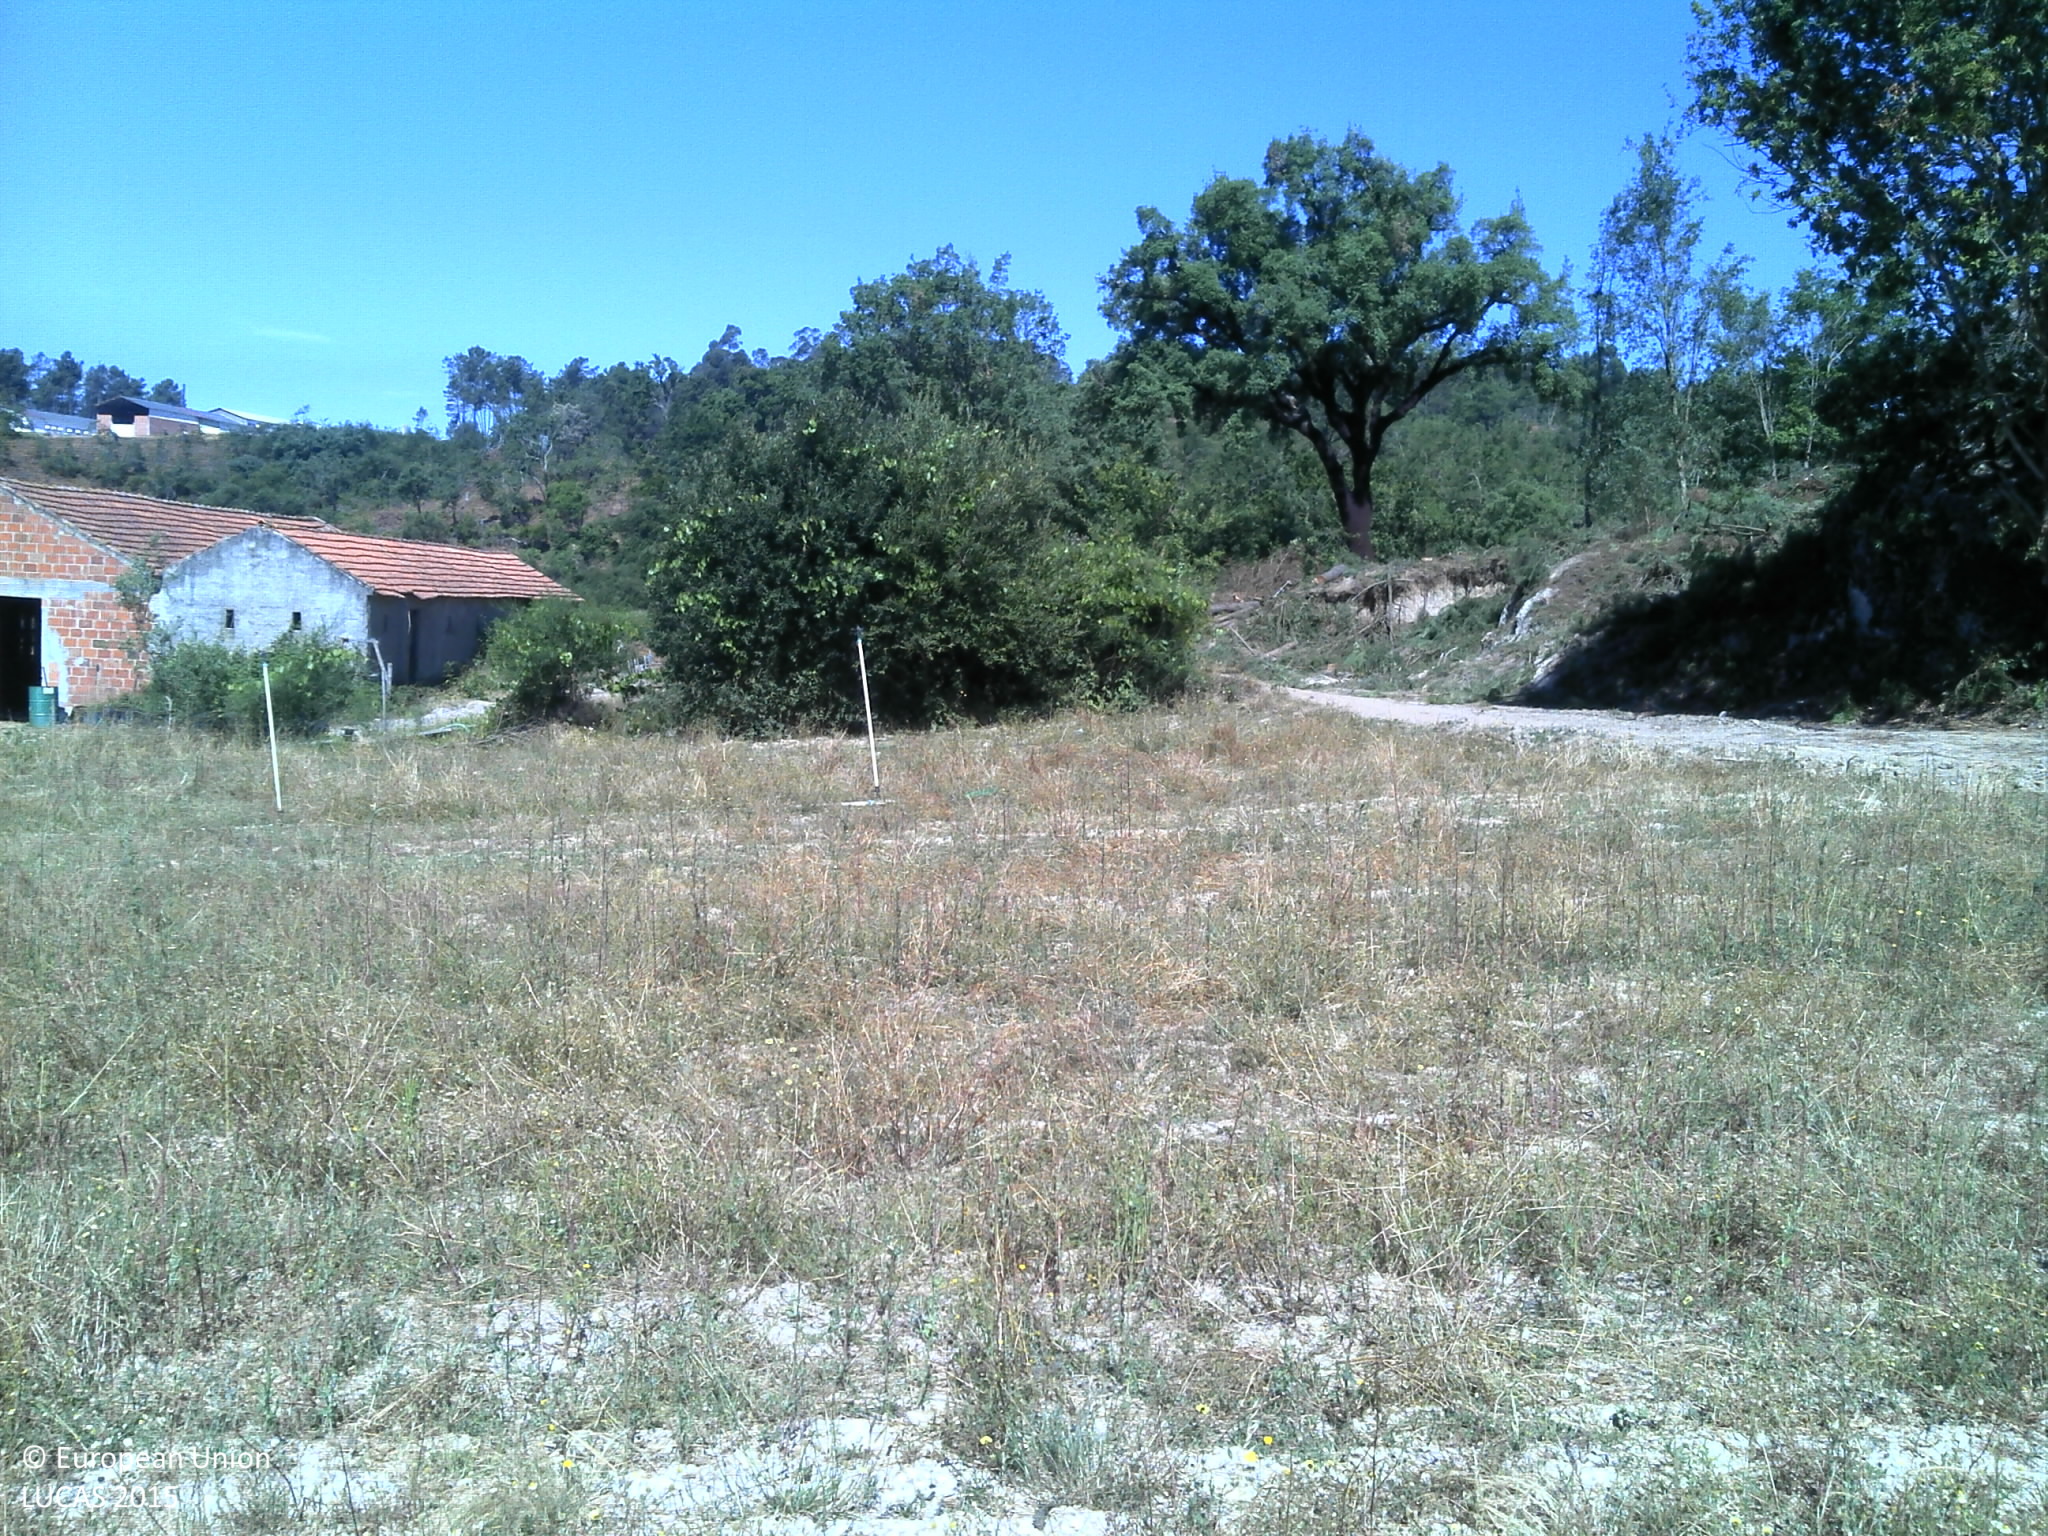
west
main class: Grassland
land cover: Spontaneously vegetated surfaces
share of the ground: > 75 %
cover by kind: herbaceous plants 75 %, unconsolidated bare surface 25 %
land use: Agriculture (excluding fallow land and kitchen gardens)
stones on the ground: < 10 %
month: June
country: PT
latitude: 40.5956
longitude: -8.0285
